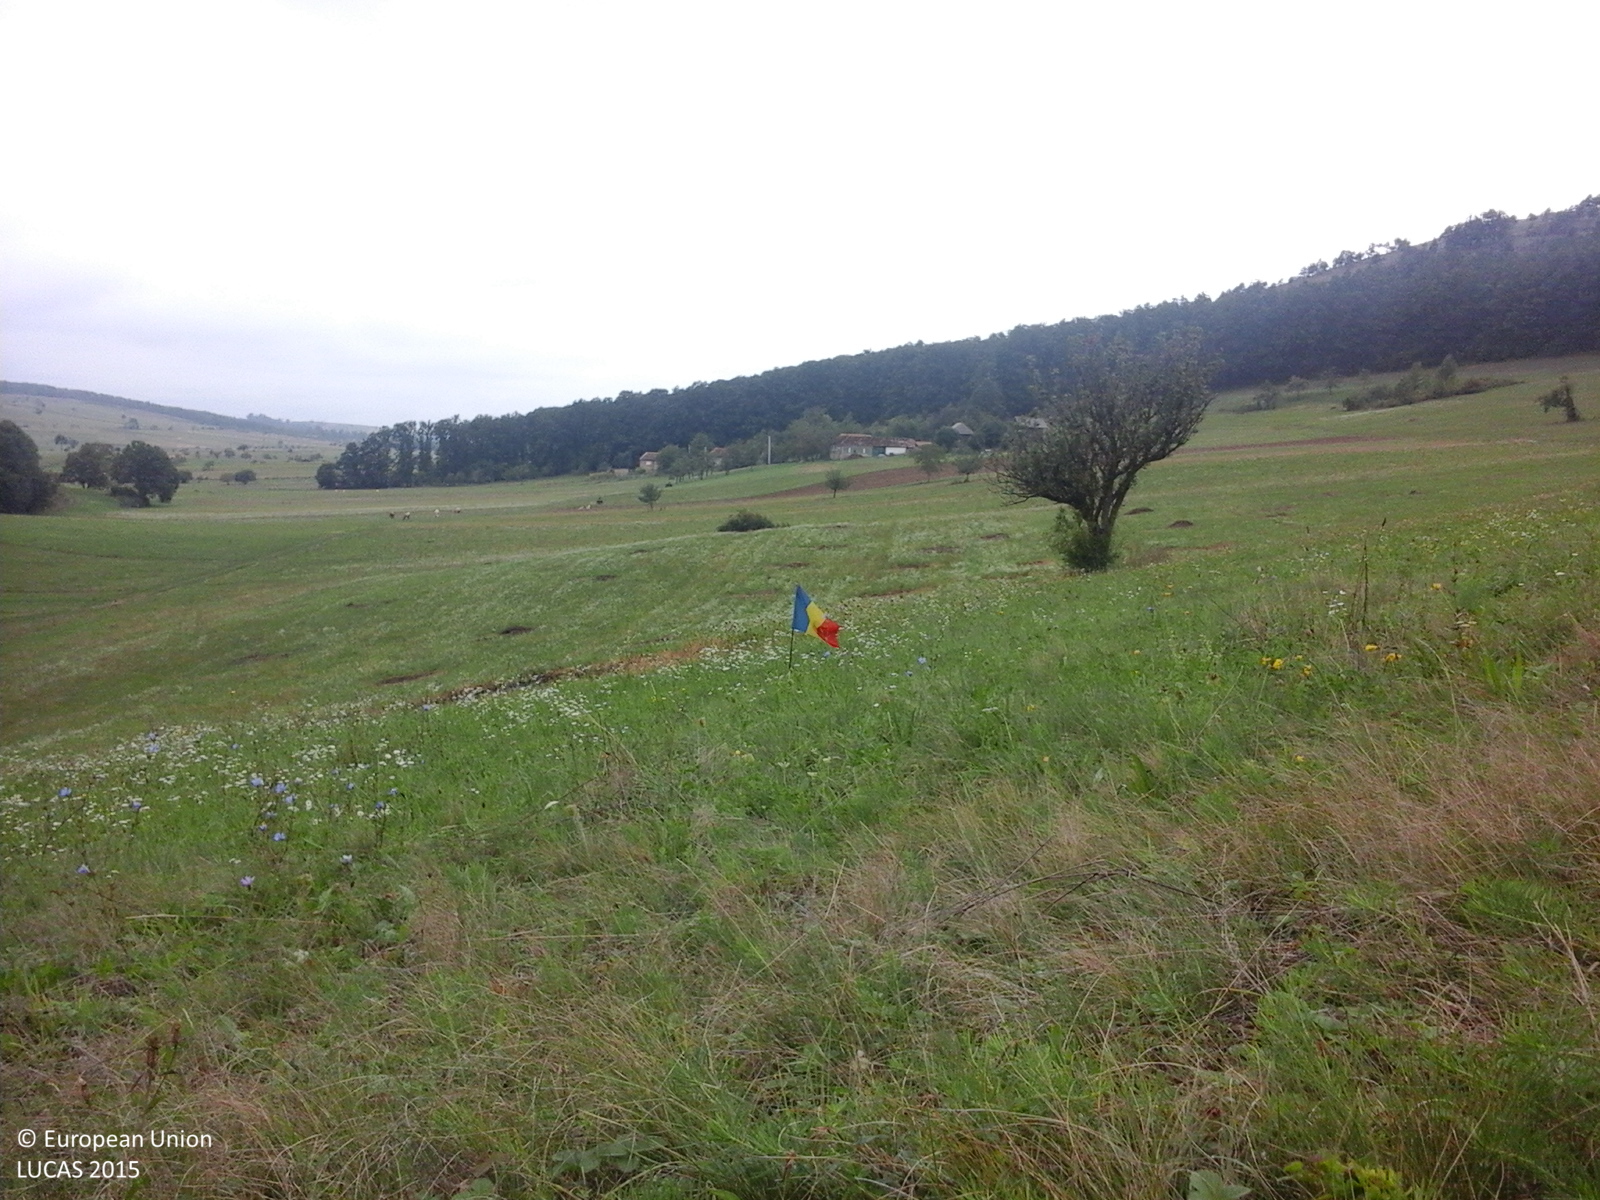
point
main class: Grassland
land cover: Grassland without tree/shrub cover
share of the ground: > 75 %
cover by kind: herbaceous plants 100 %
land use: Agriculture (excluding fallow land and kitchen gardens)
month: September
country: RO
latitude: 46.9983
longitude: 22.3479
